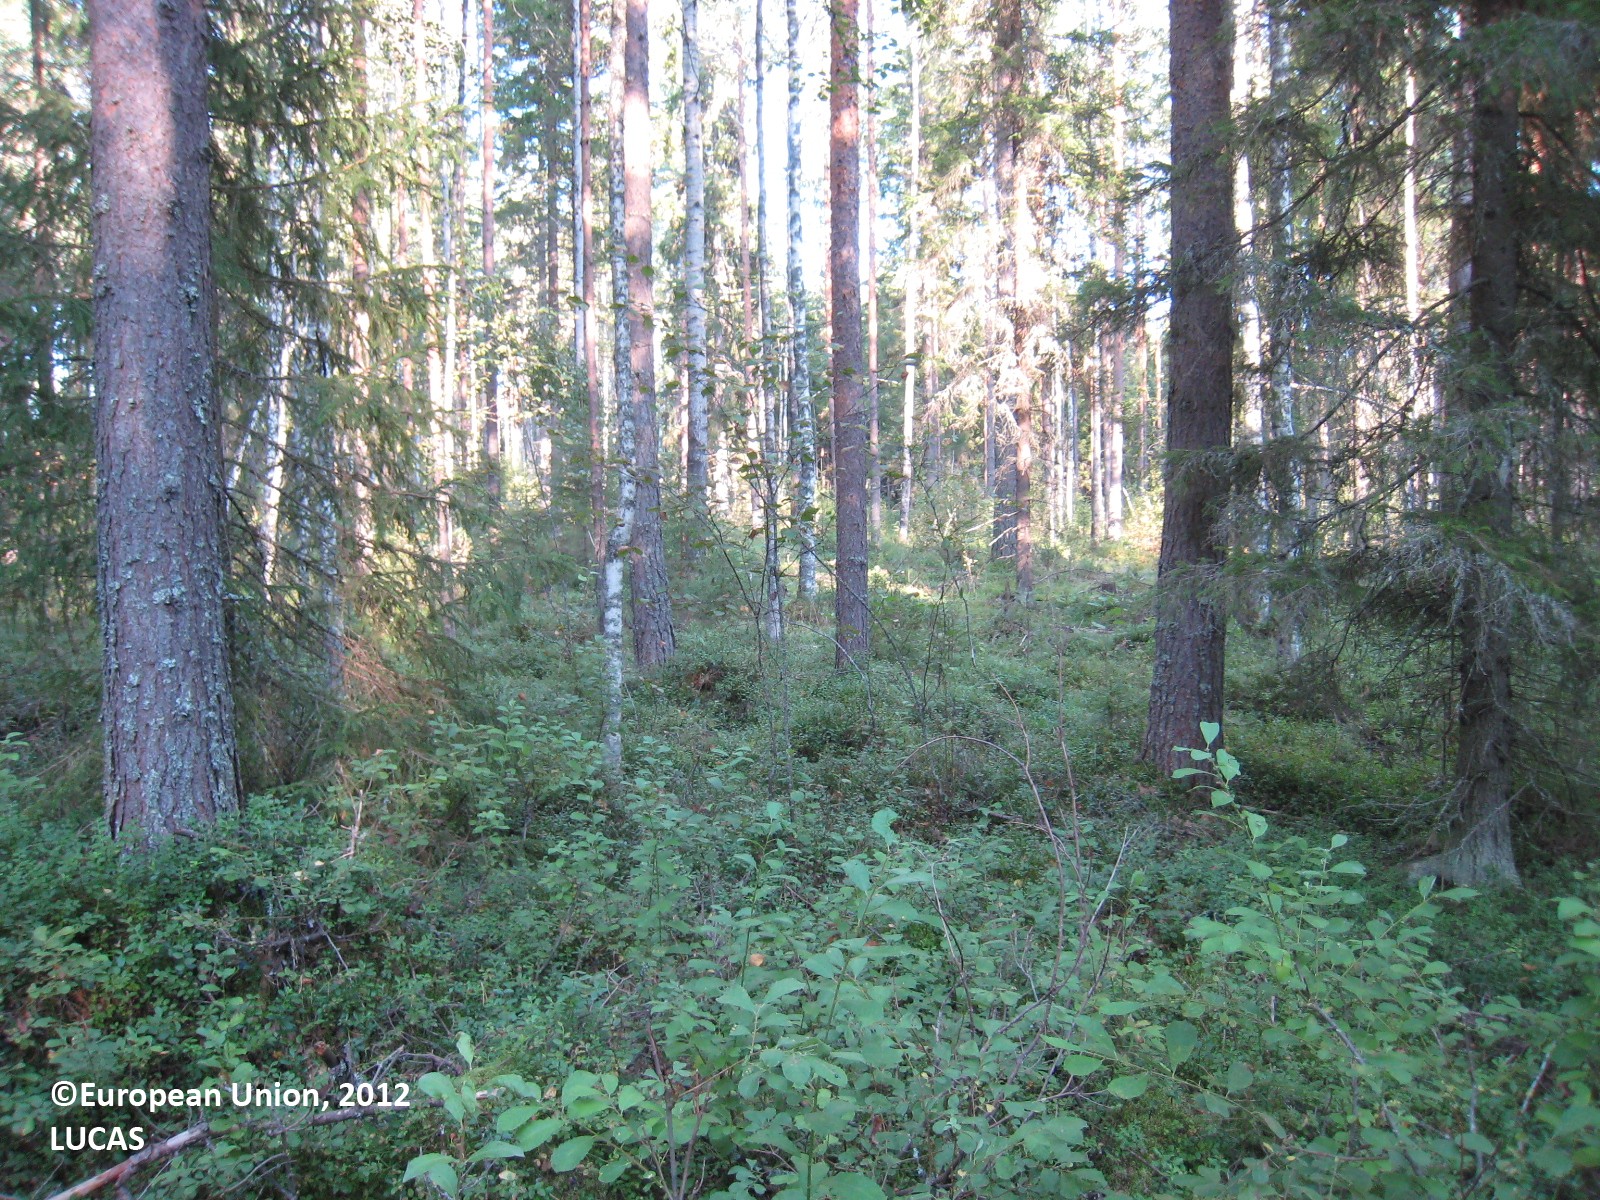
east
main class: Woodland
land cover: Other mixed woodland
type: boreal forest
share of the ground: > 75 %
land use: Forestry
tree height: > 5 m
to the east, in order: Other mixed woodland; Pine dominated coniferous woodland; Spruce dominated coniferous woodland; Broadleaved woodland; Other mixed woodland
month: August
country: FI
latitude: 62.1024
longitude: 27.2725
